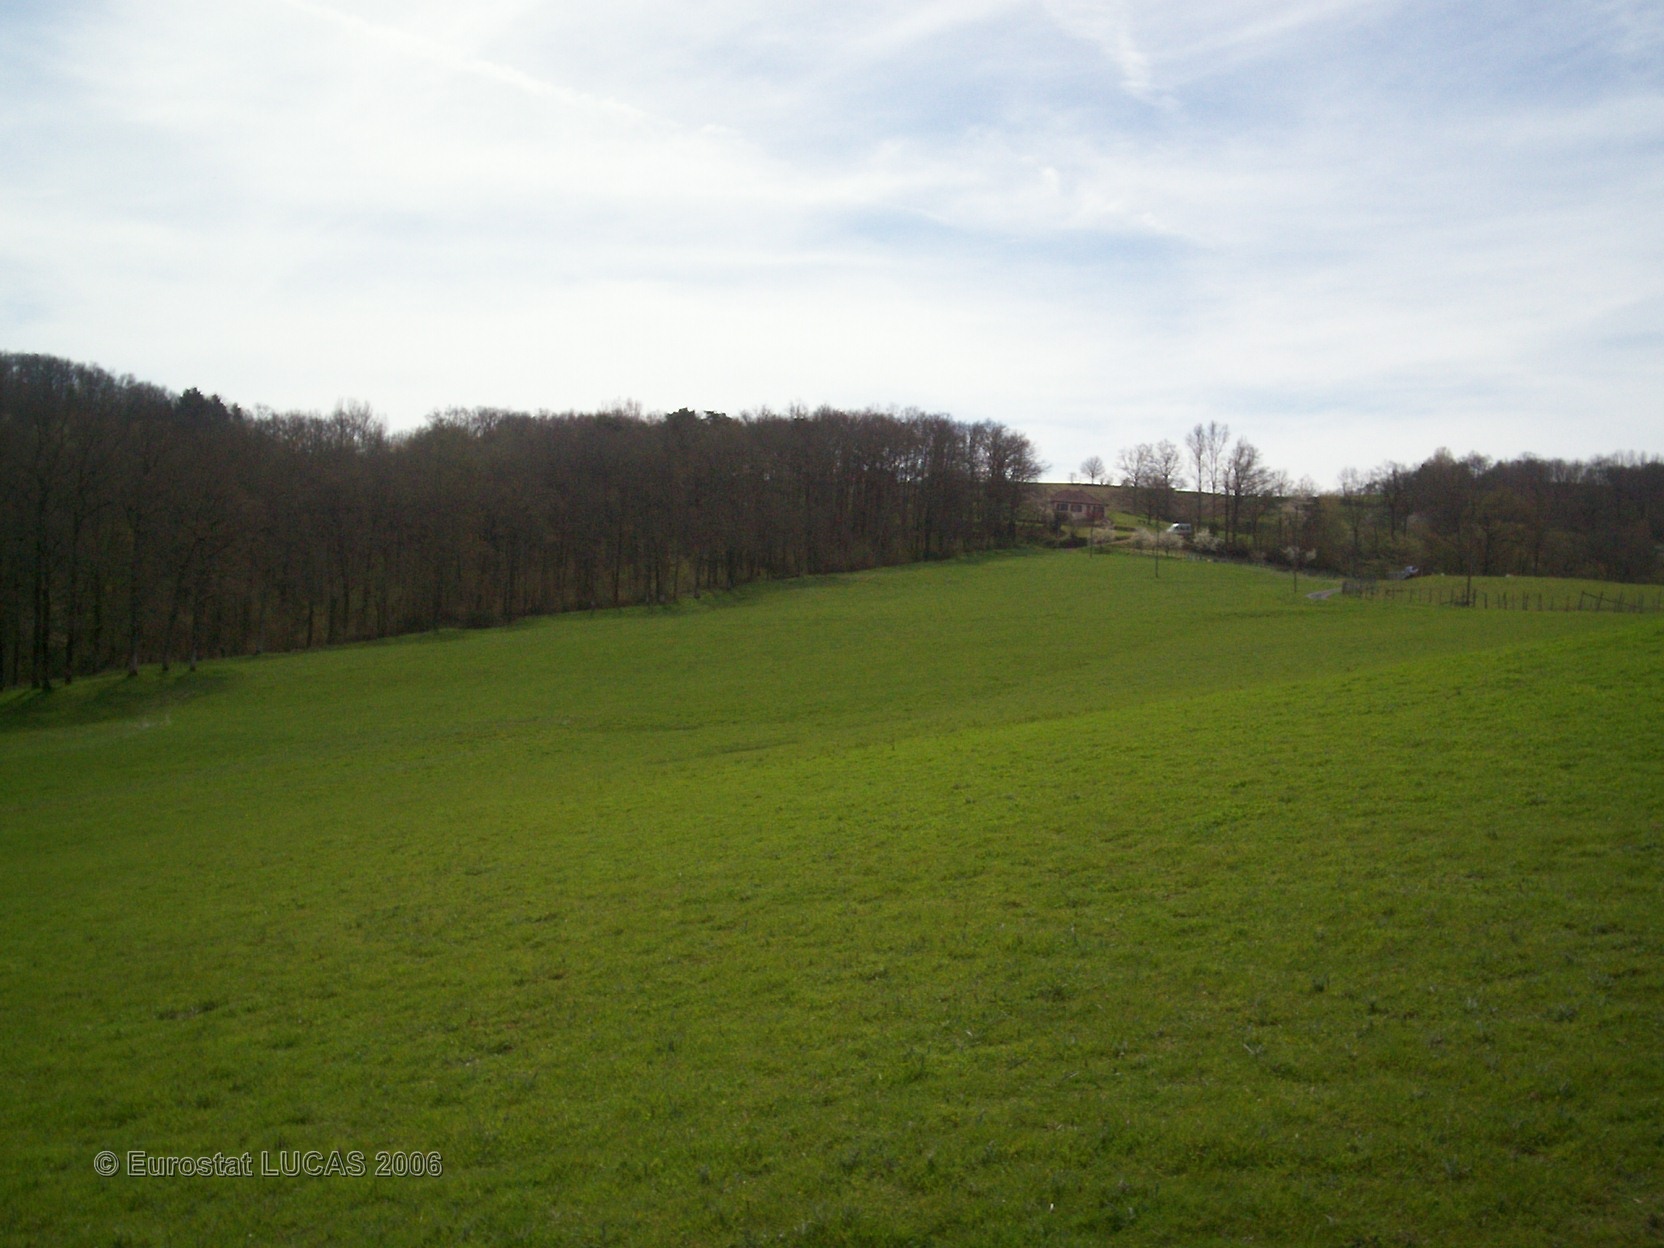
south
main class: Grassland
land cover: Grassland without tree/shrub cover
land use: Agriculture (excluding fallow land and kitchen gardens)
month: April
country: FR
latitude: 45.2169
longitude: 1.2964
